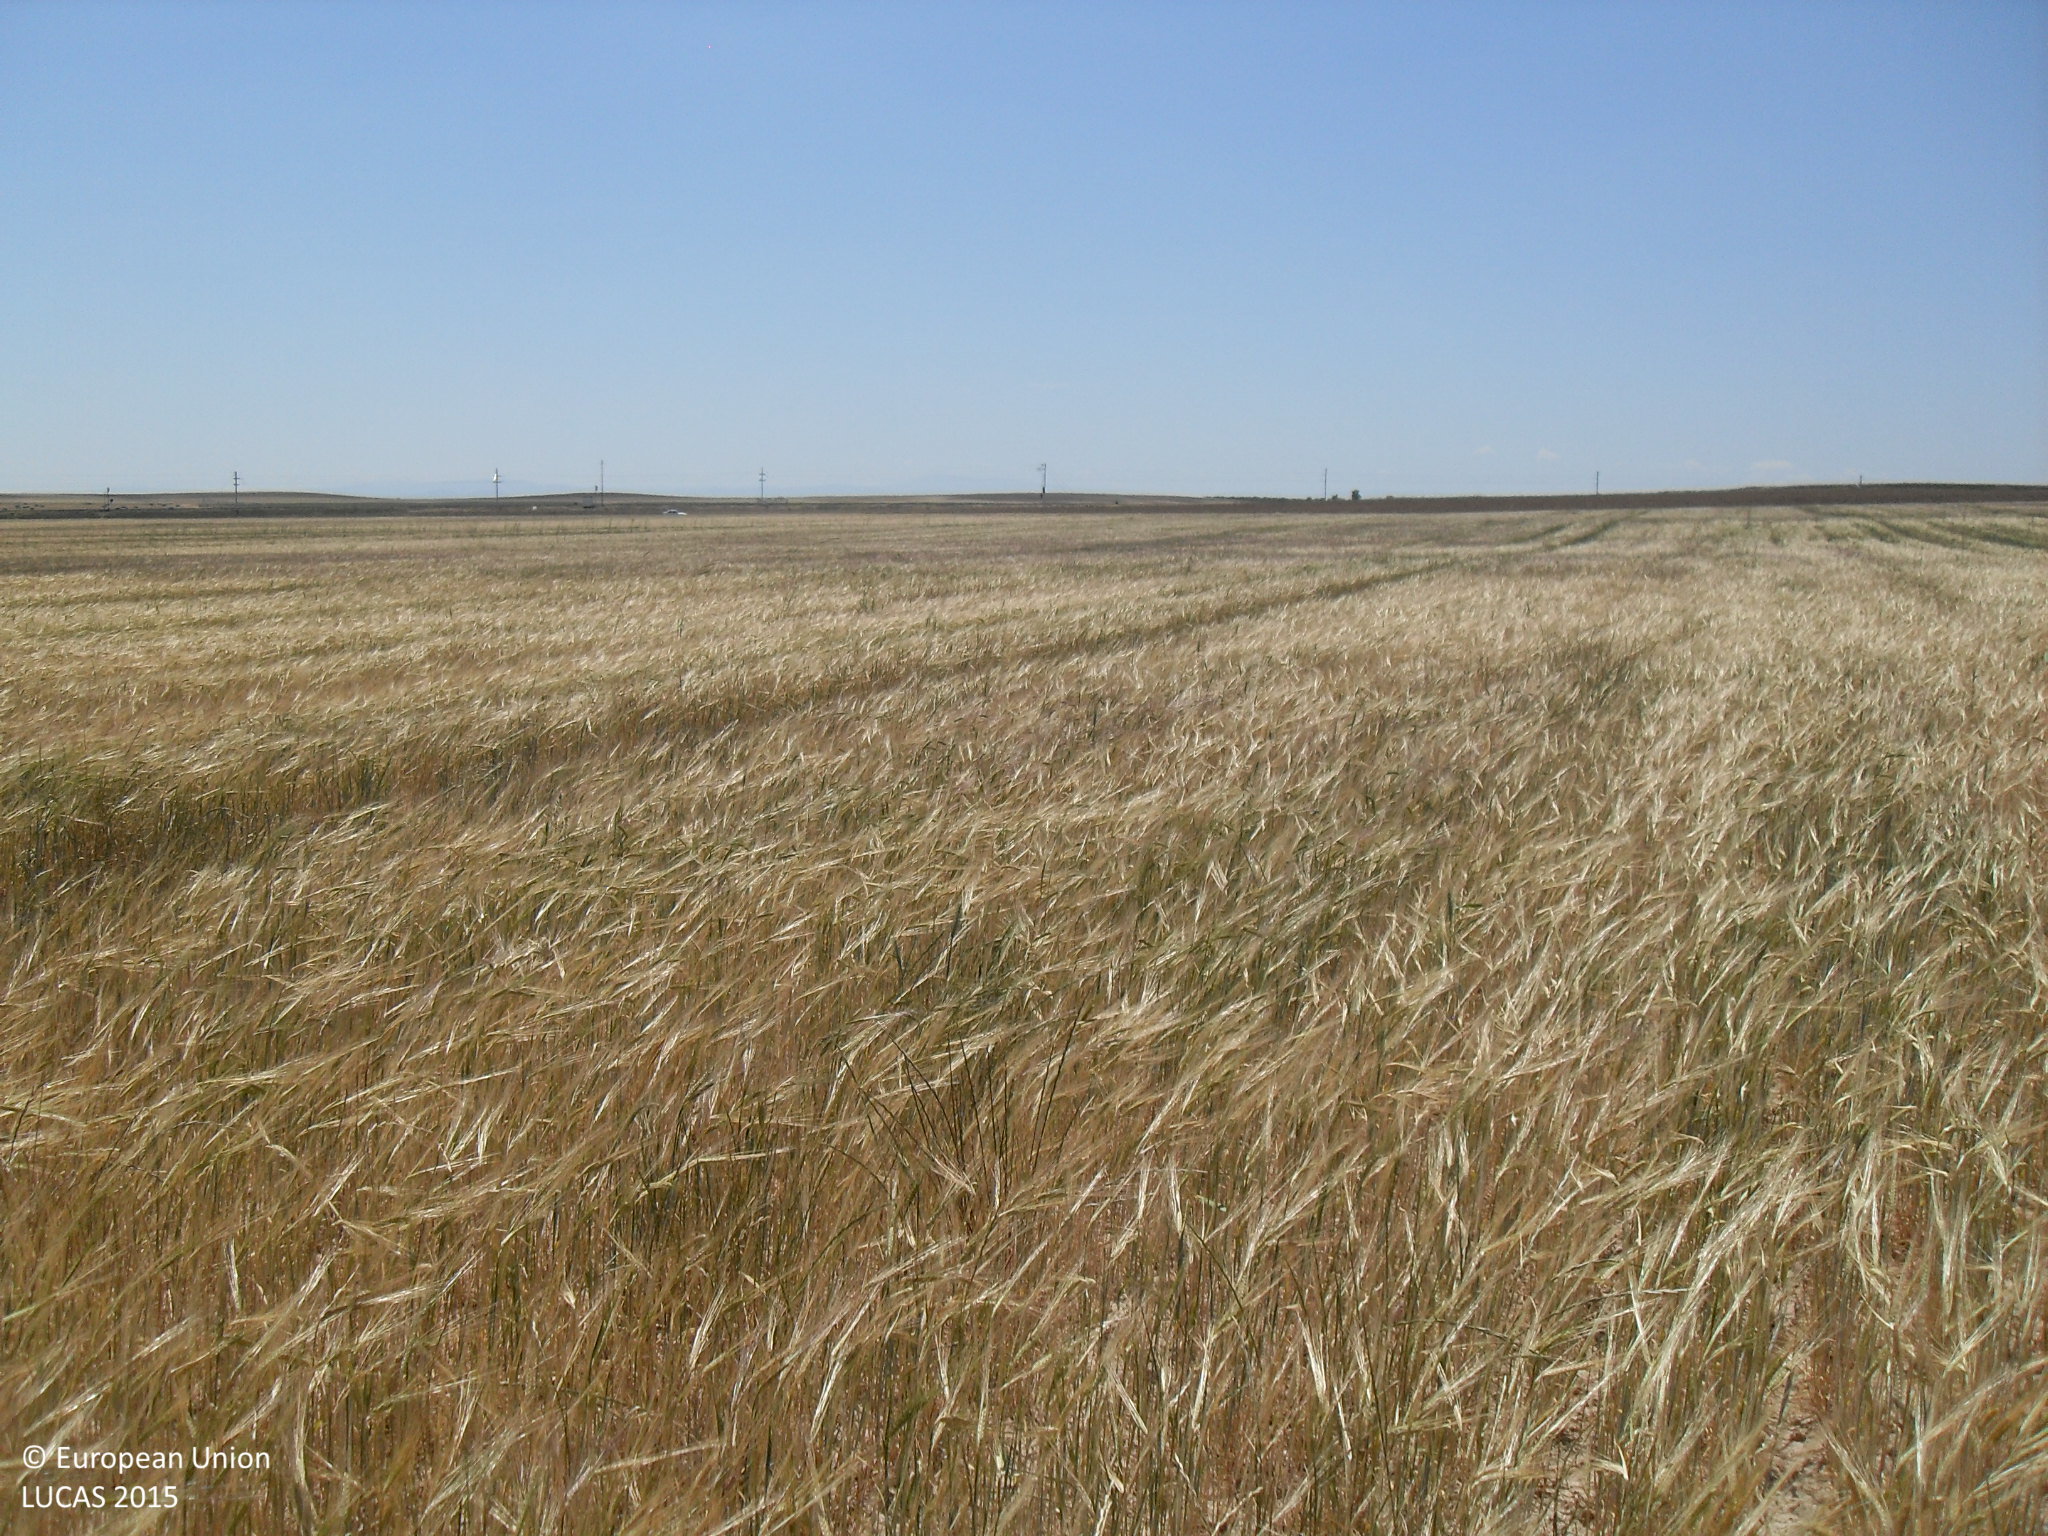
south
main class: Cropland
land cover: Barley
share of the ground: > 75 %
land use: Agriculture (excluding fallow land and kitchen gardens)
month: May
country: ES
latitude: 41.1304
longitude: -5.2111
